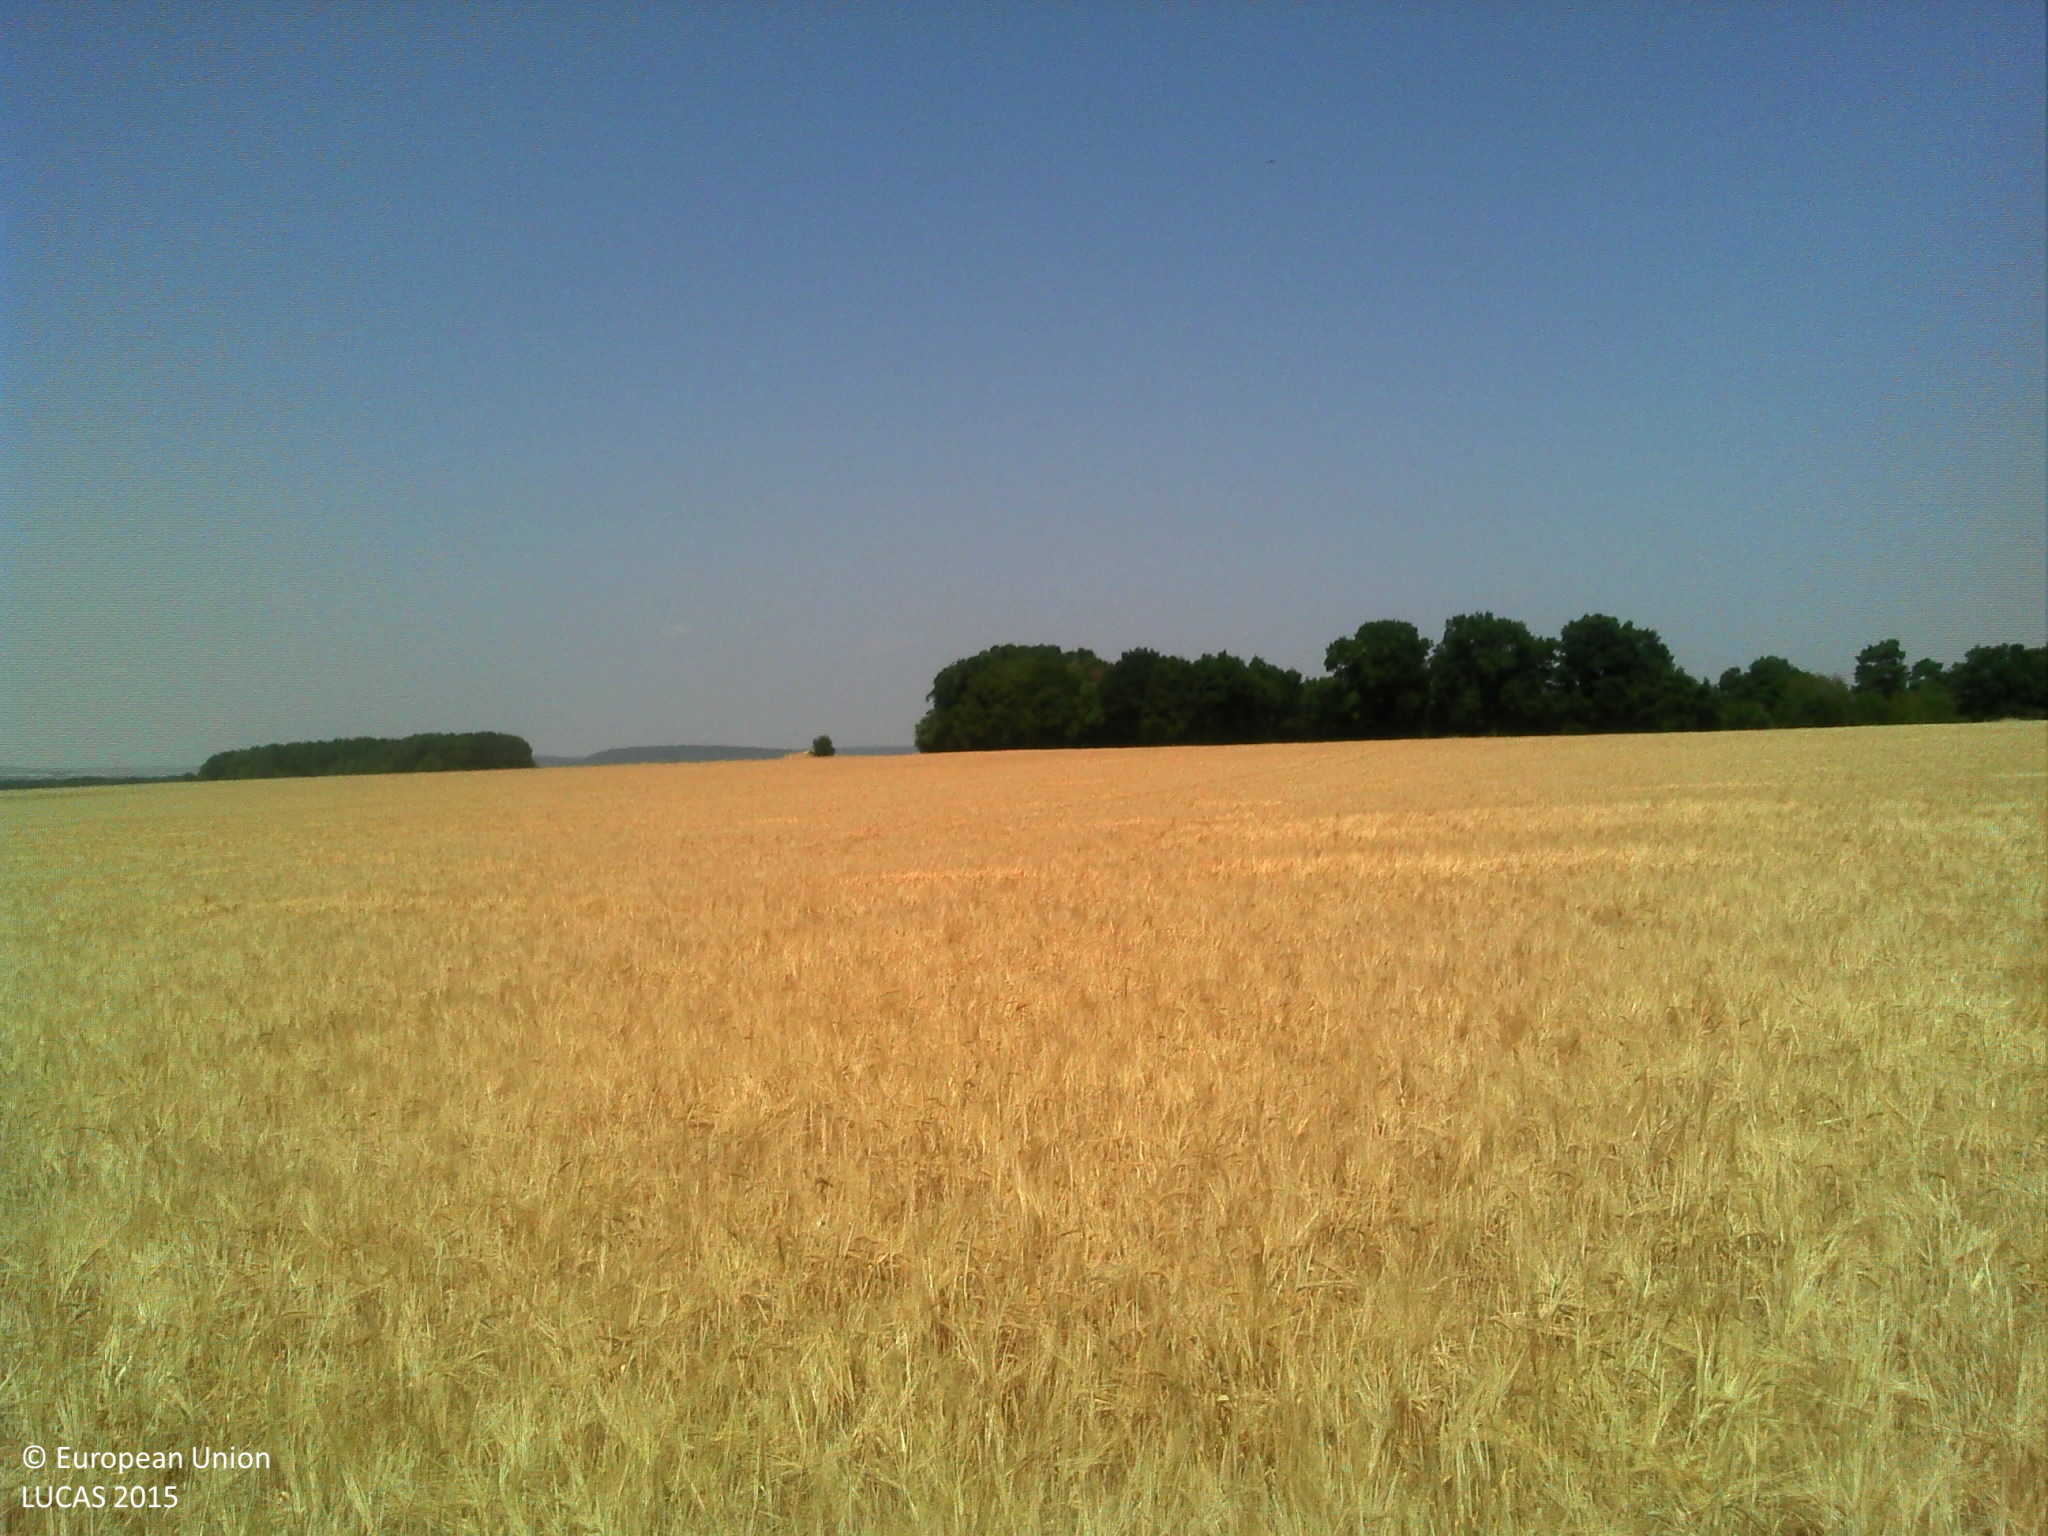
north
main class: Cropland
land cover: Barley
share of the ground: > 75 %
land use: Agriculture (excluding fallow land and kitchen gardens)
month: July
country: FR
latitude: 47.9803
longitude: 4.9214
